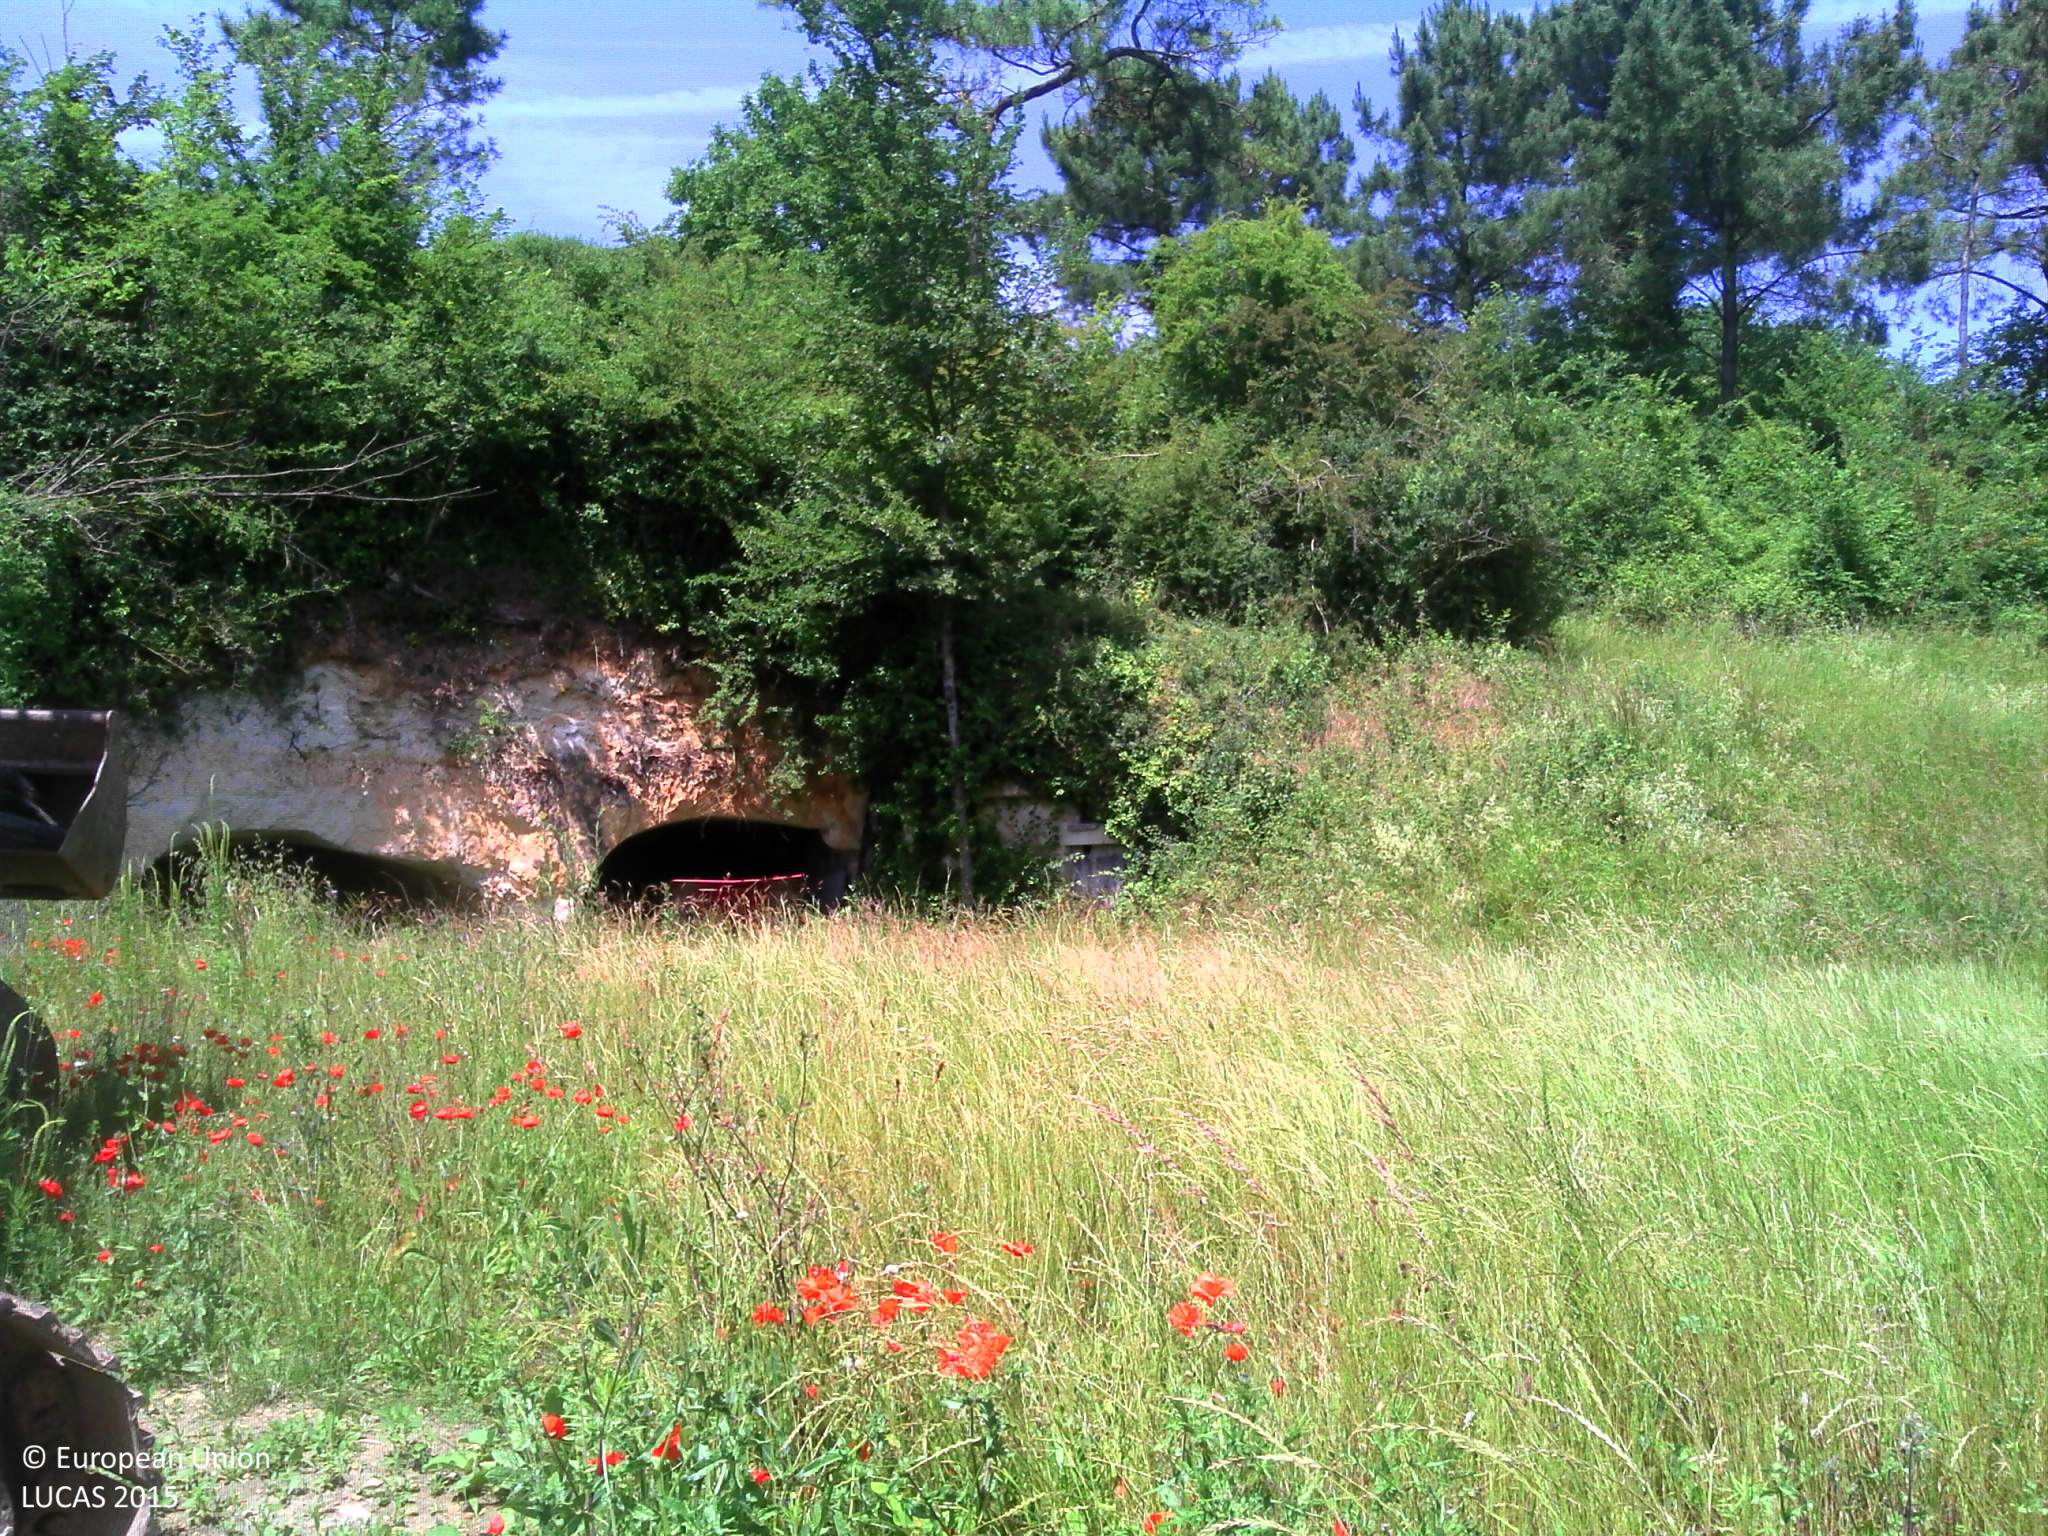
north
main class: Grassland
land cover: Spontaneously vegetated surfaces
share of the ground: 50 - 75 %
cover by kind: herbaceous plants 75 %, consolidated bare surface 25 %
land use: Construction
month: June
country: FR
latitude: 47.6280
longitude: 0.4629
